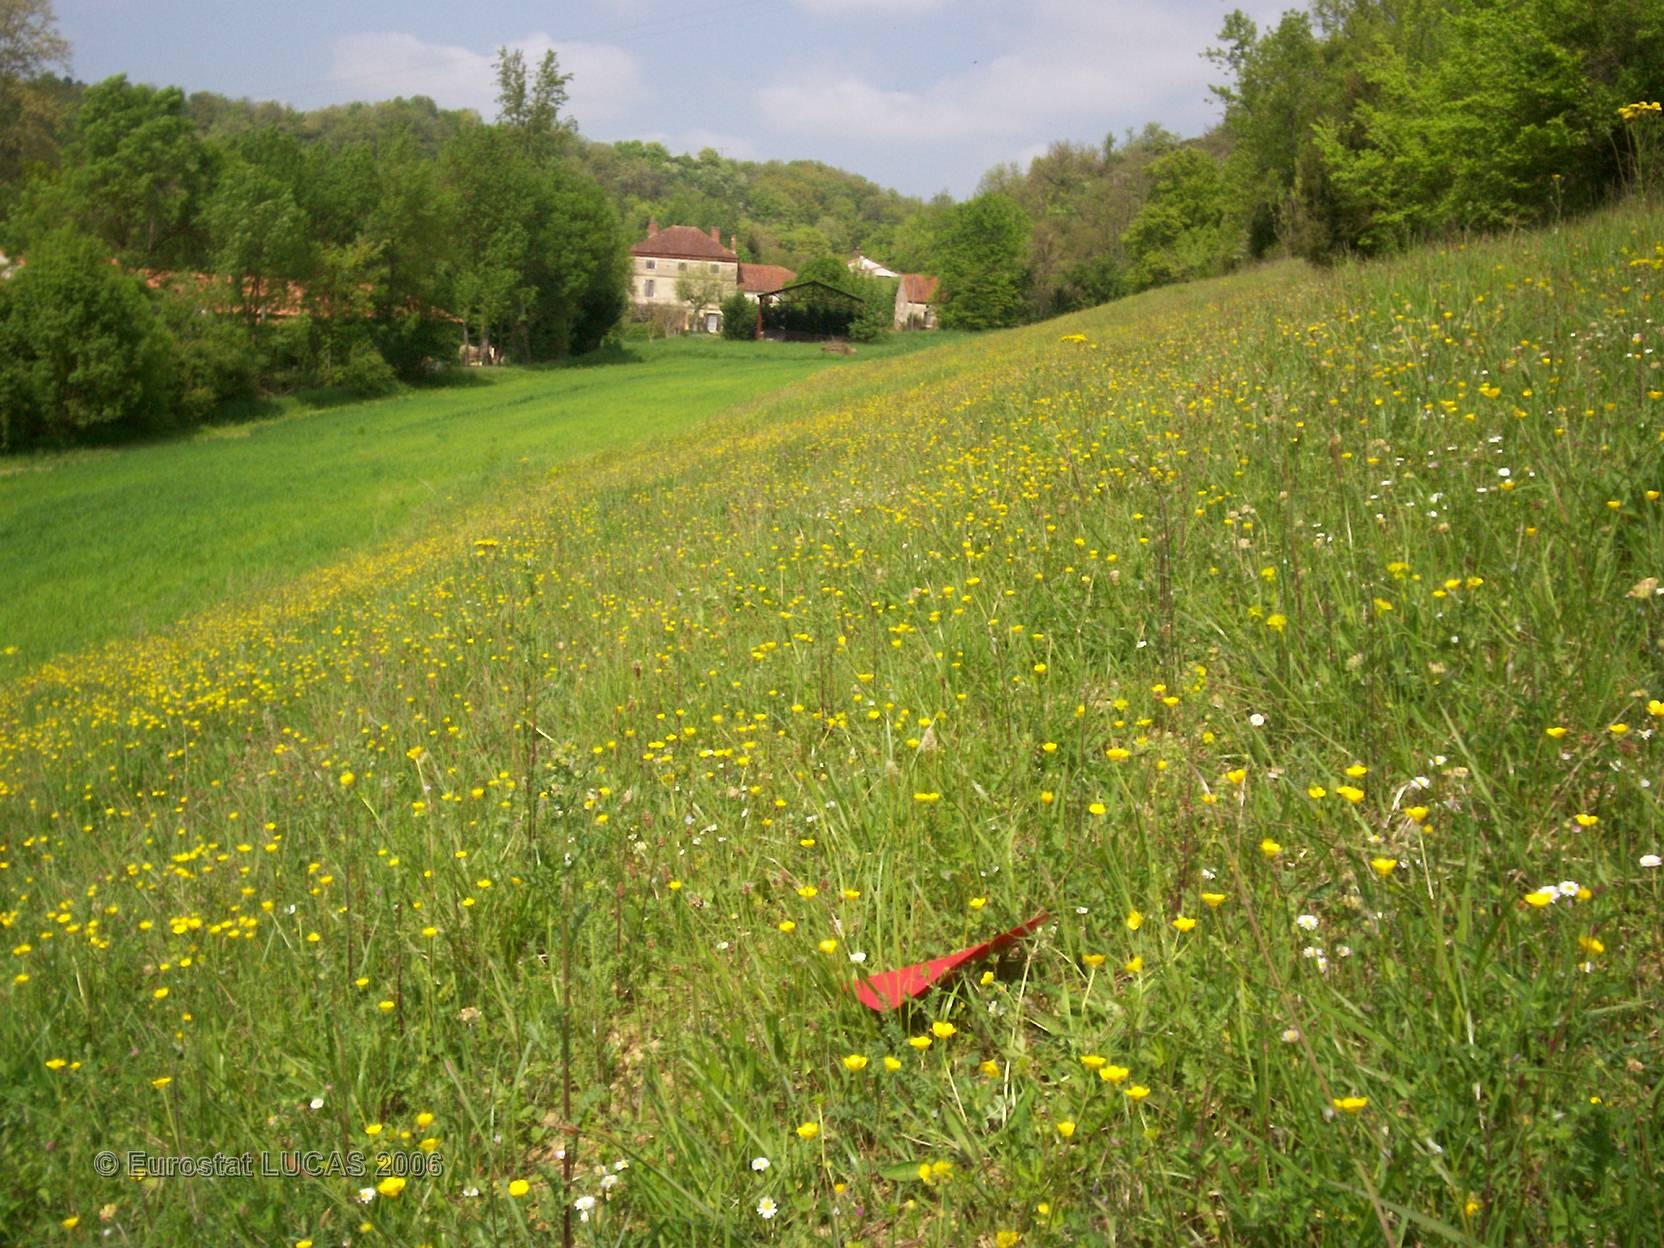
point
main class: Grassland
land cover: Grassland without tree/shrub cover
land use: Agriculture (excluding fallow land and kitchen gardens)
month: April
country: FR
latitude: 44.1571
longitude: 0.7805
